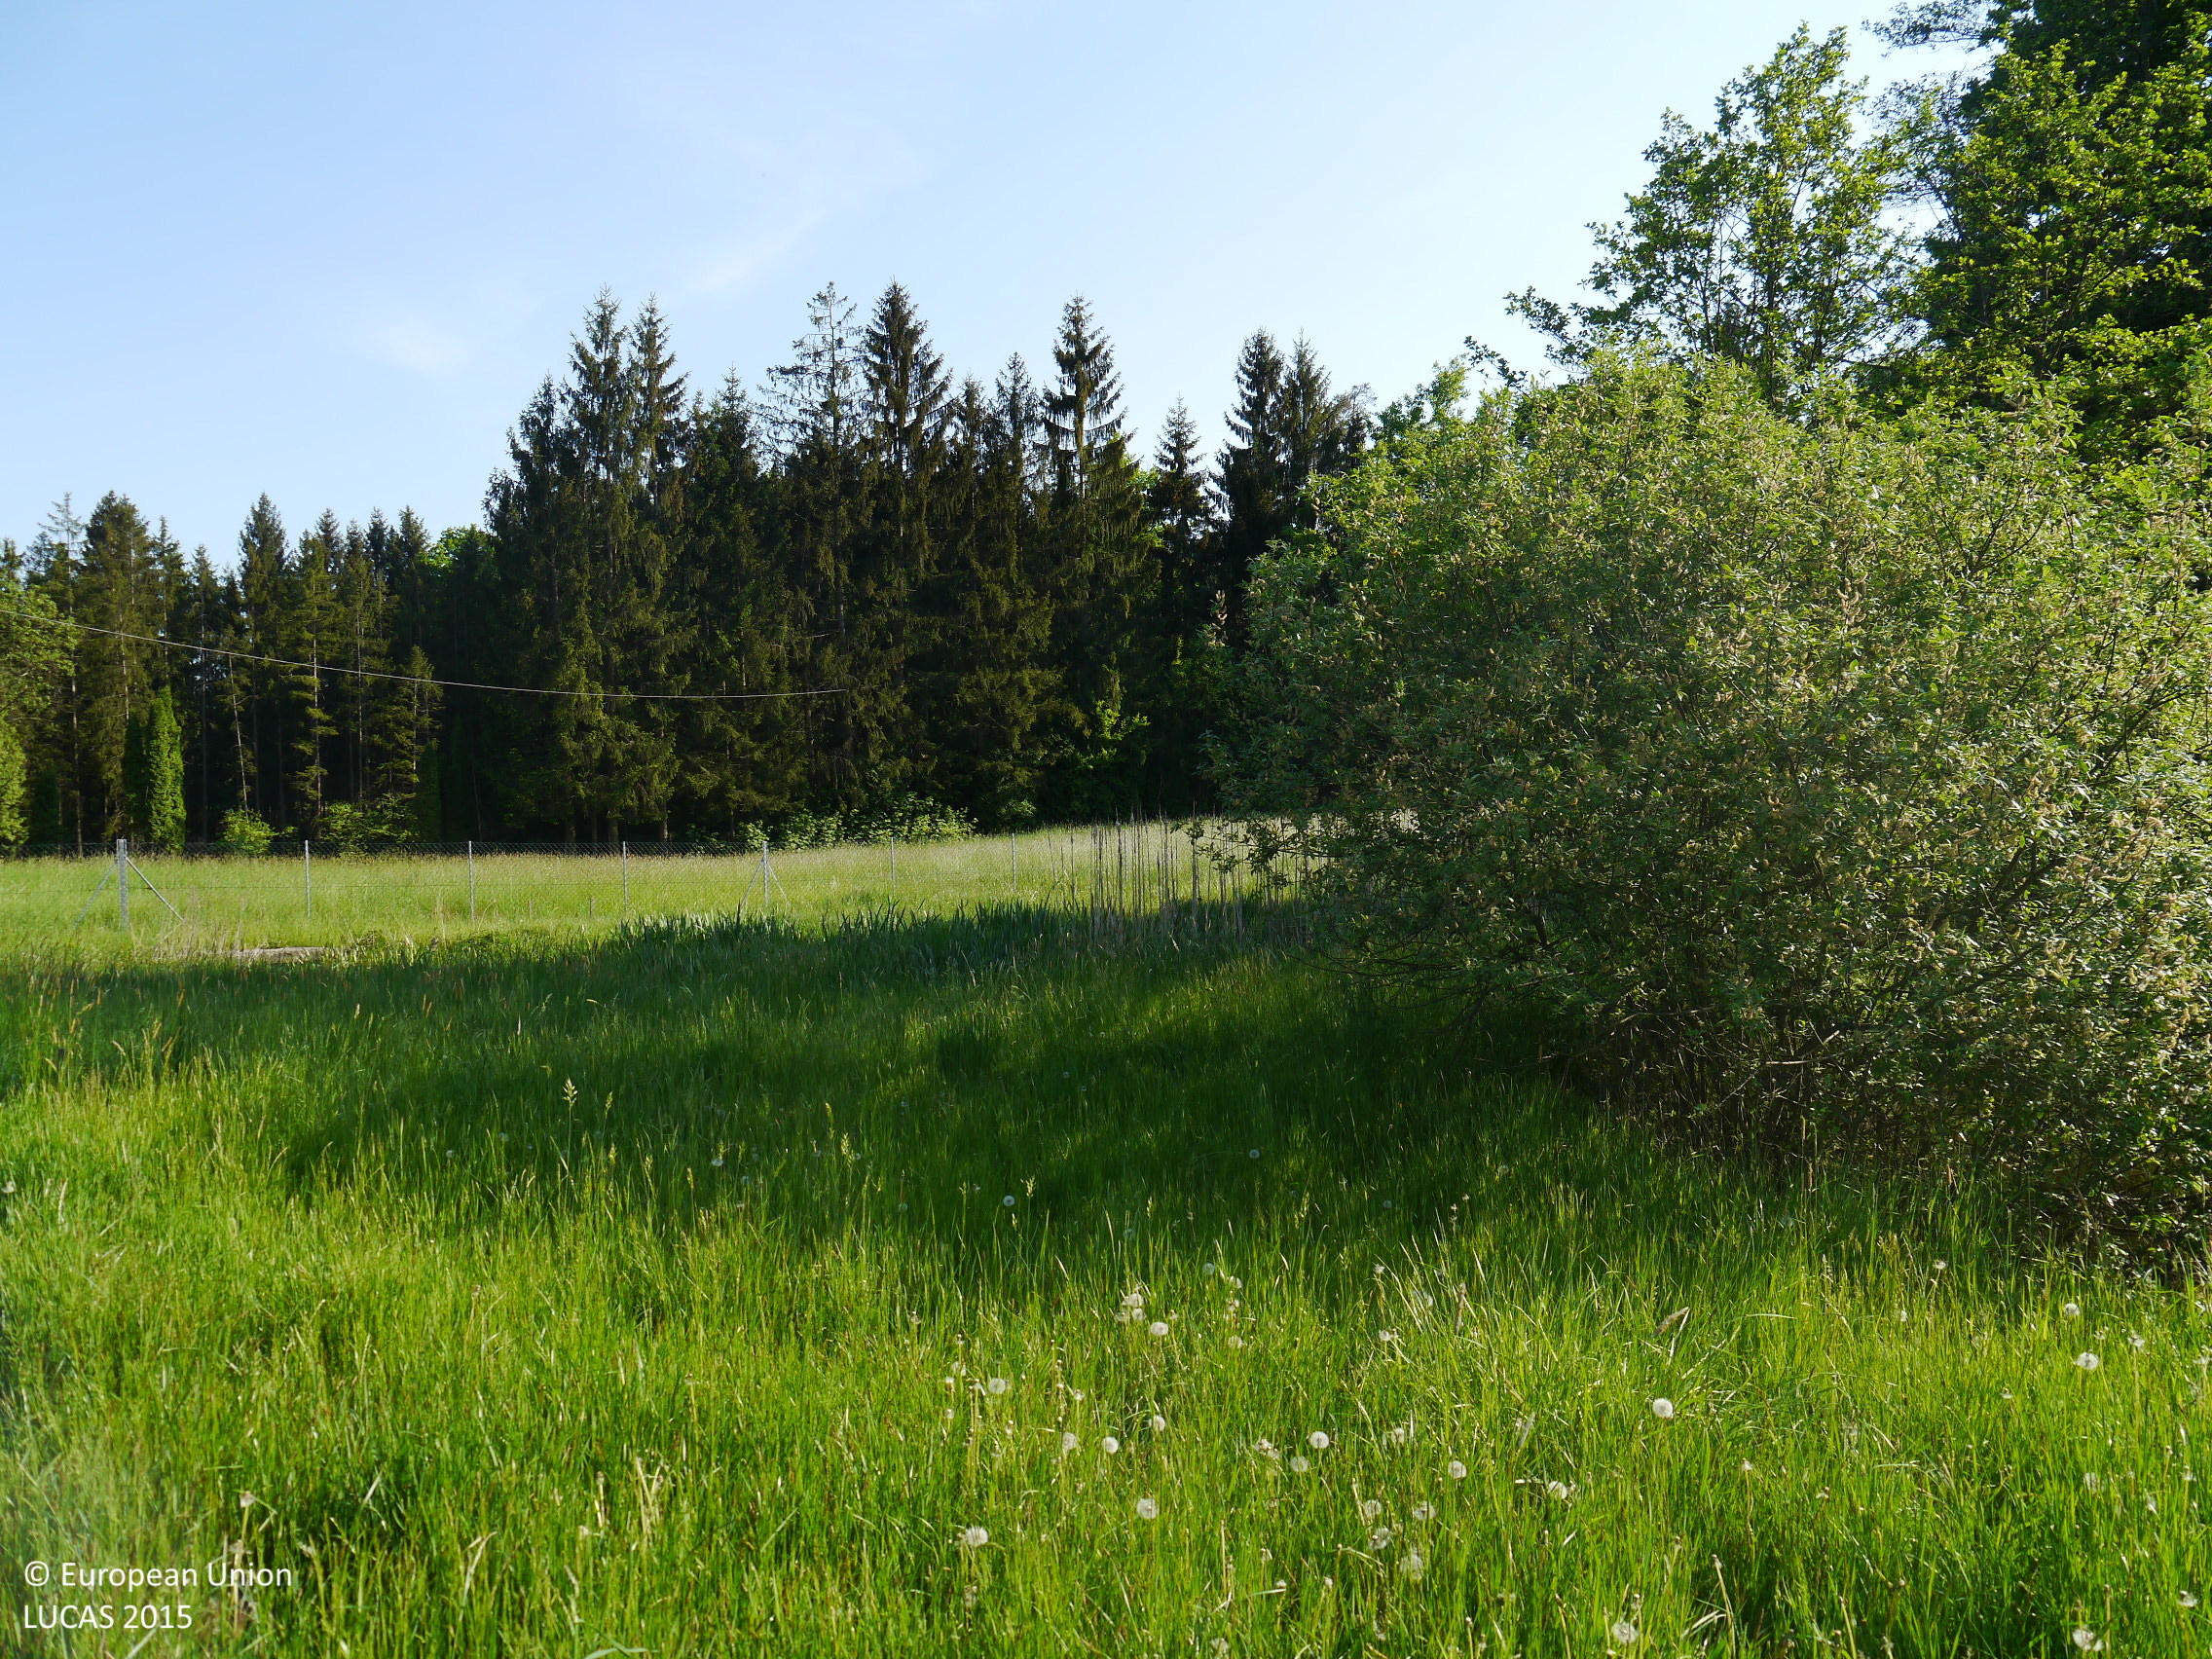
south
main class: Cropland
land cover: Common wheat
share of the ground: > 75 %
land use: Agriculture (excluding fallow land and kitchen gardens)
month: May
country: AT
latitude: 46.9548
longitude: 15.4001
